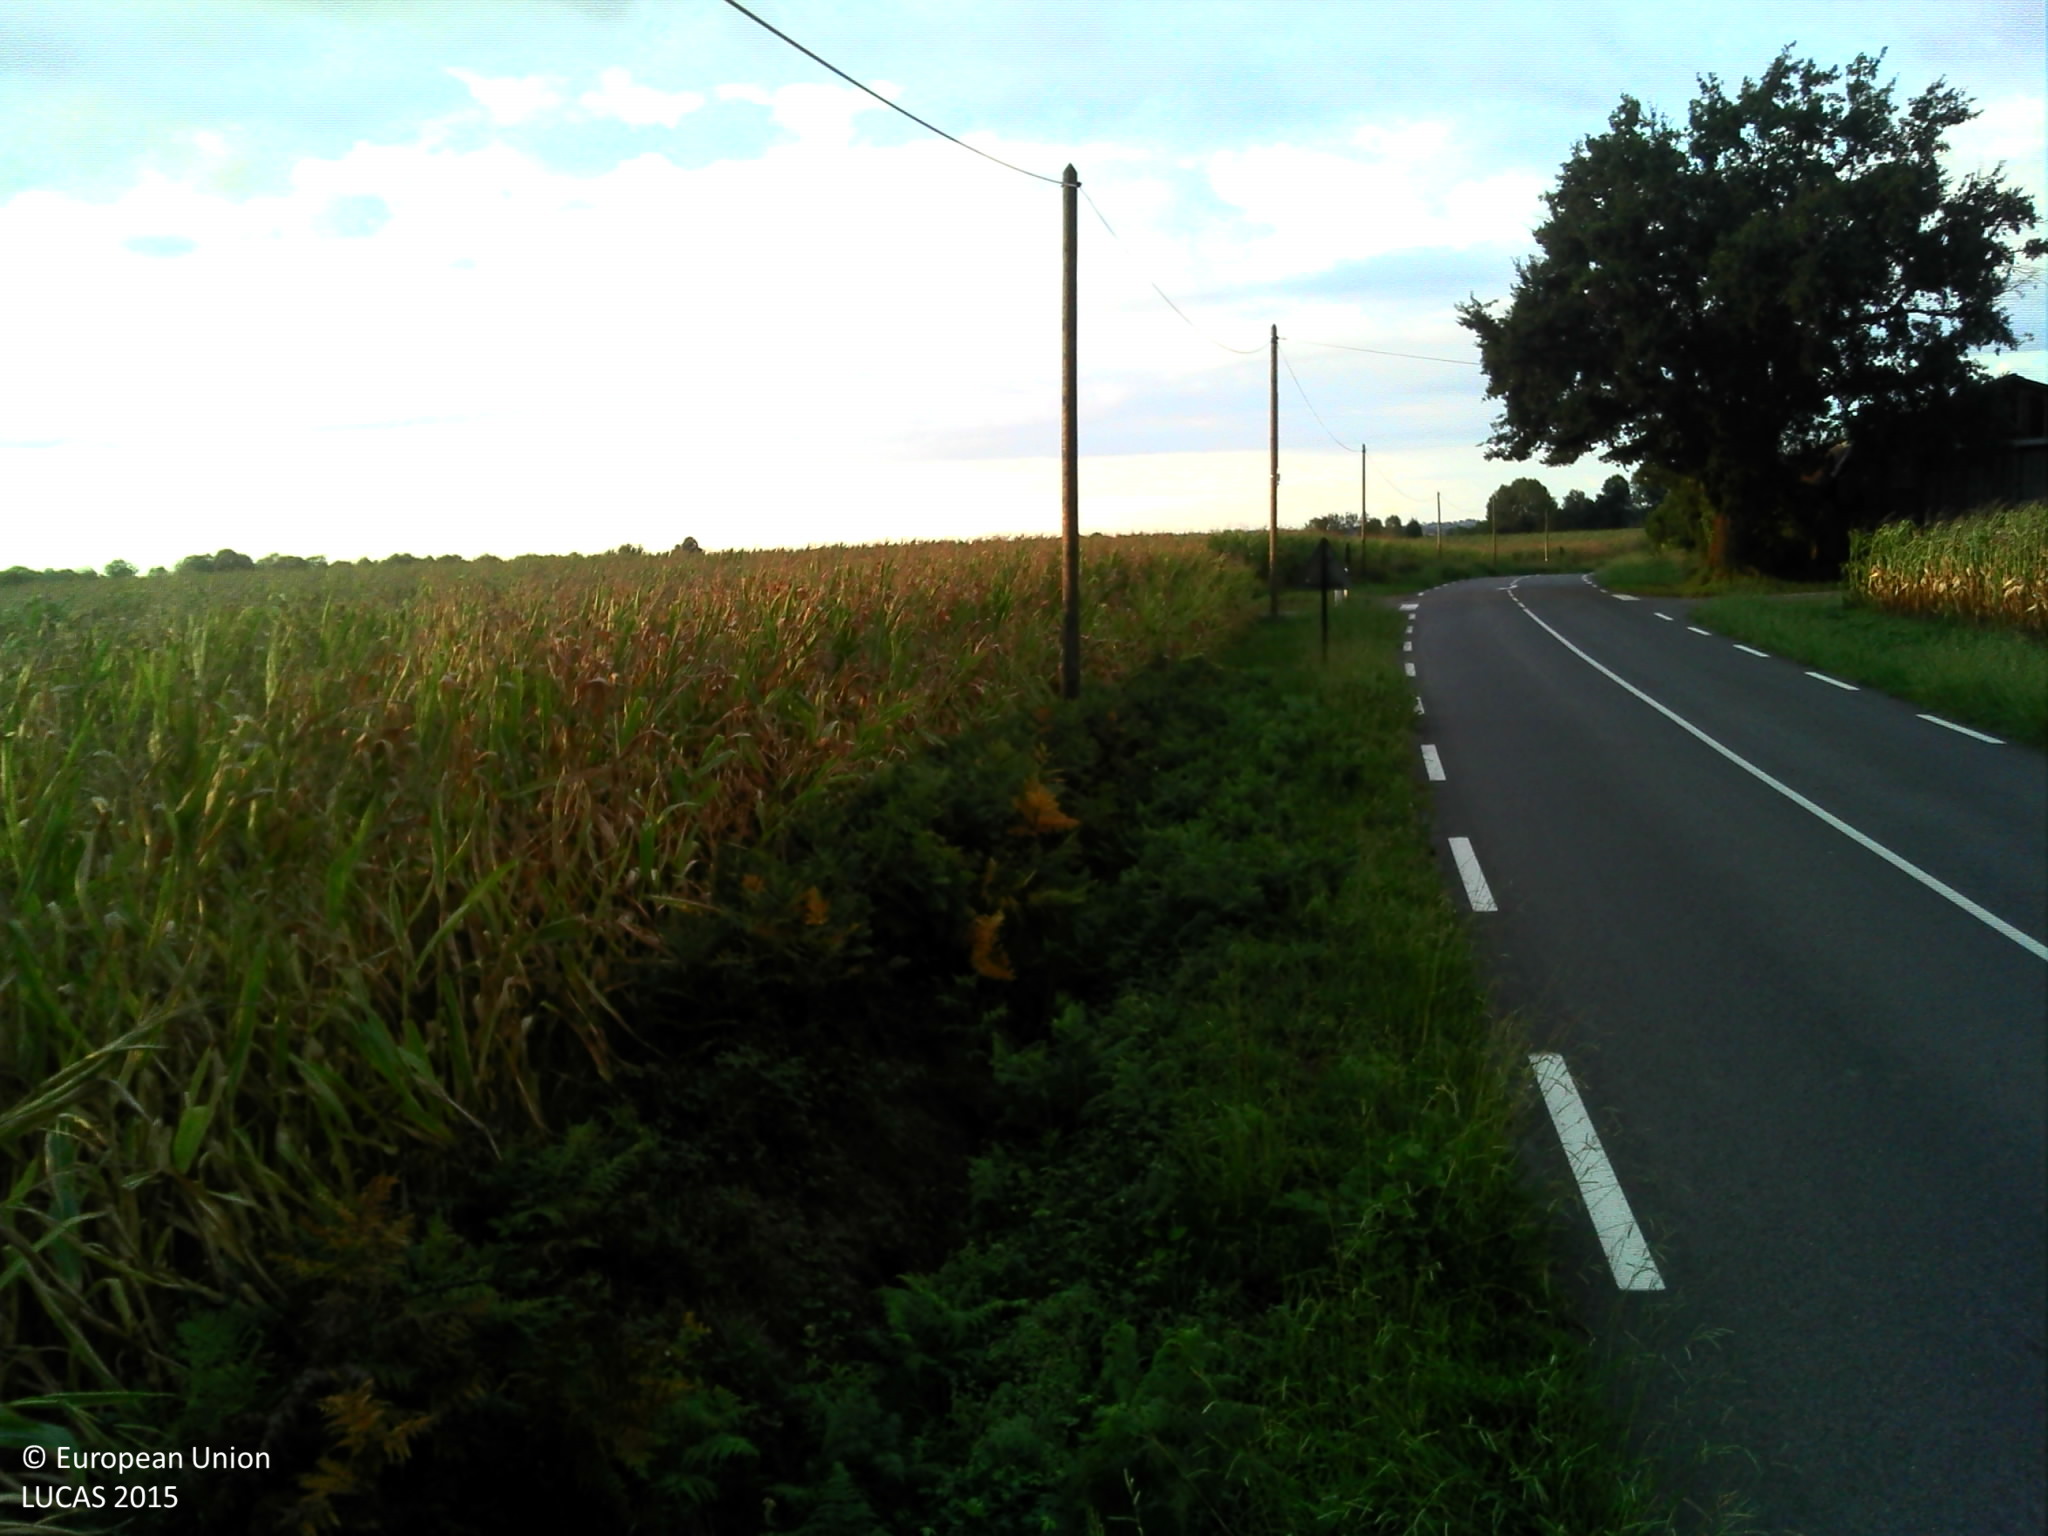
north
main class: Cropland
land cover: Maize
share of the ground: > 75 %
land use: Agriculture (excluding fallow land and kitchen gardens)
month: September
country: FR
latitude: 43.3864
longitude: -0.4389
